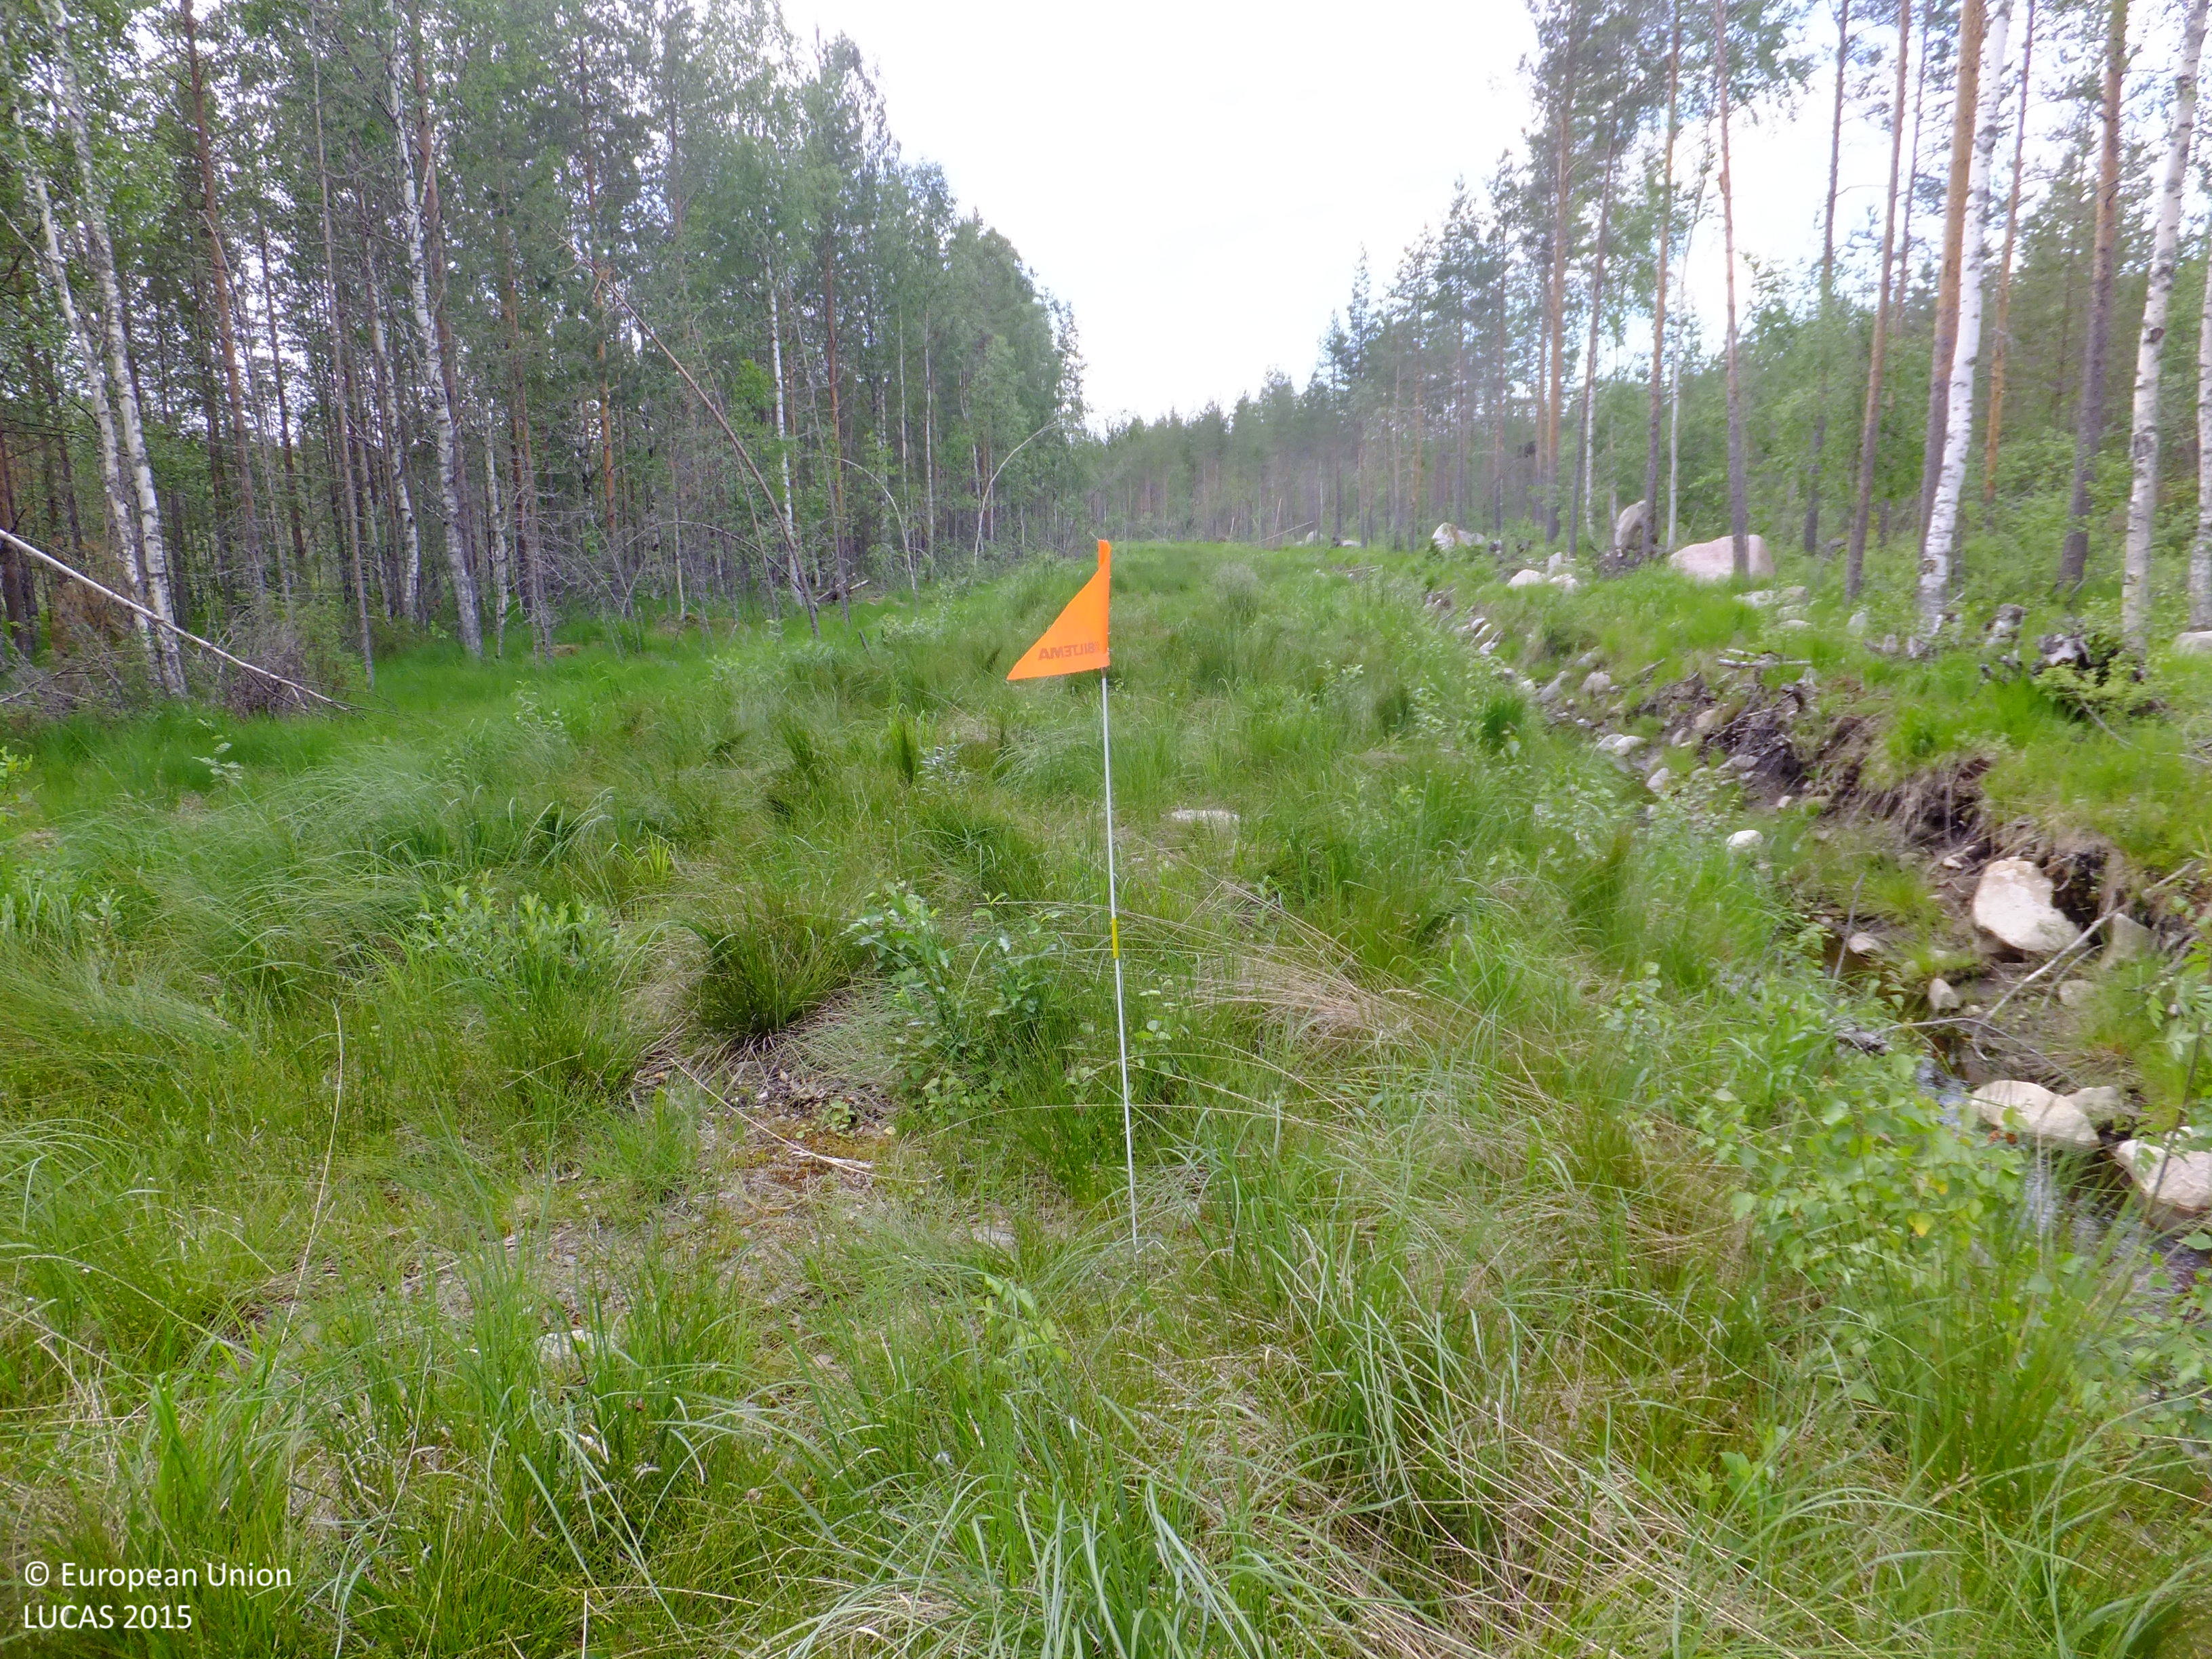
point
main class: Grassland
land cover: Grassland without tree/shrub cover
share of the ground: > 75 %
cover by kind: herbaceous plants 75 %, lichens and mosses 10 %, shrubs 5 %, consolidated bare surface 5 %, unconsolidated bare surface 5 %
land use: Abandoned areas
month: July
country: FI
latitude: 63.5289
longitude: 24.4561
